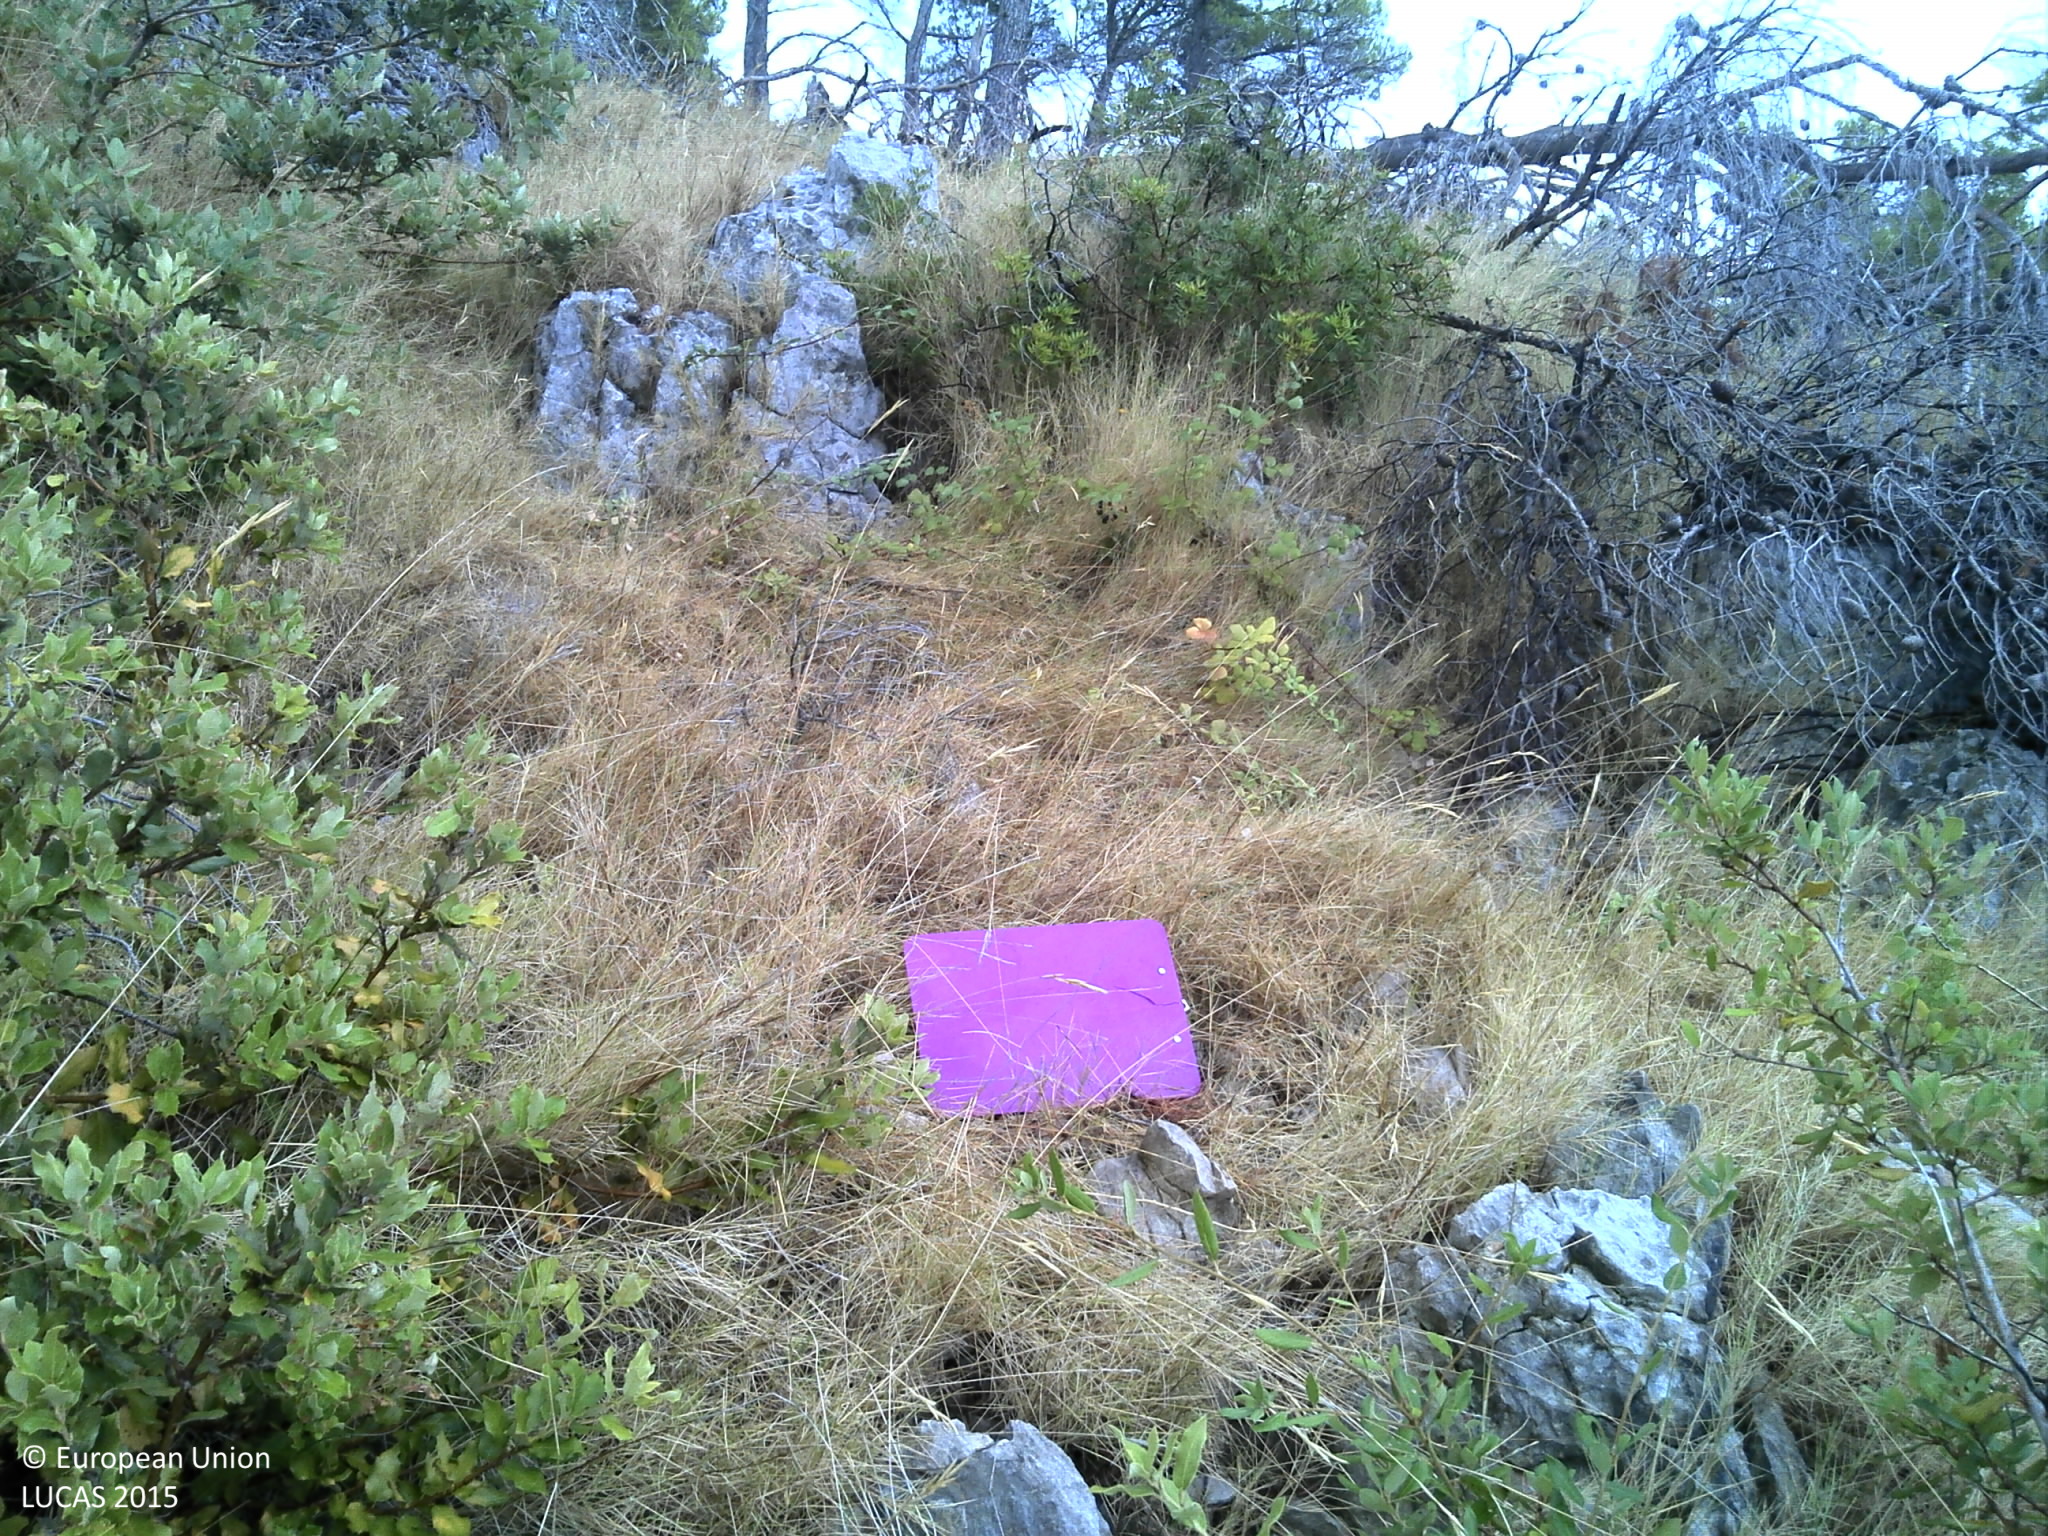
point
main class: Woodland
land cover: Pine dominated coniferous woodland
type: coniferous forest of the mediterranean region
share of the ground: 50 - 75 %
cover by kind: coniferous forest trees 50 %, shrubs 20 %, unconsolidated bare surface 15 %, herbaceous plants 10 %, consolidated bare surface 5 %
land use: Semi-natural and natural areas not in use
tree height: > 5 m
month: July
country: HR
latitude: 43.2971
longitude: 16.4859
